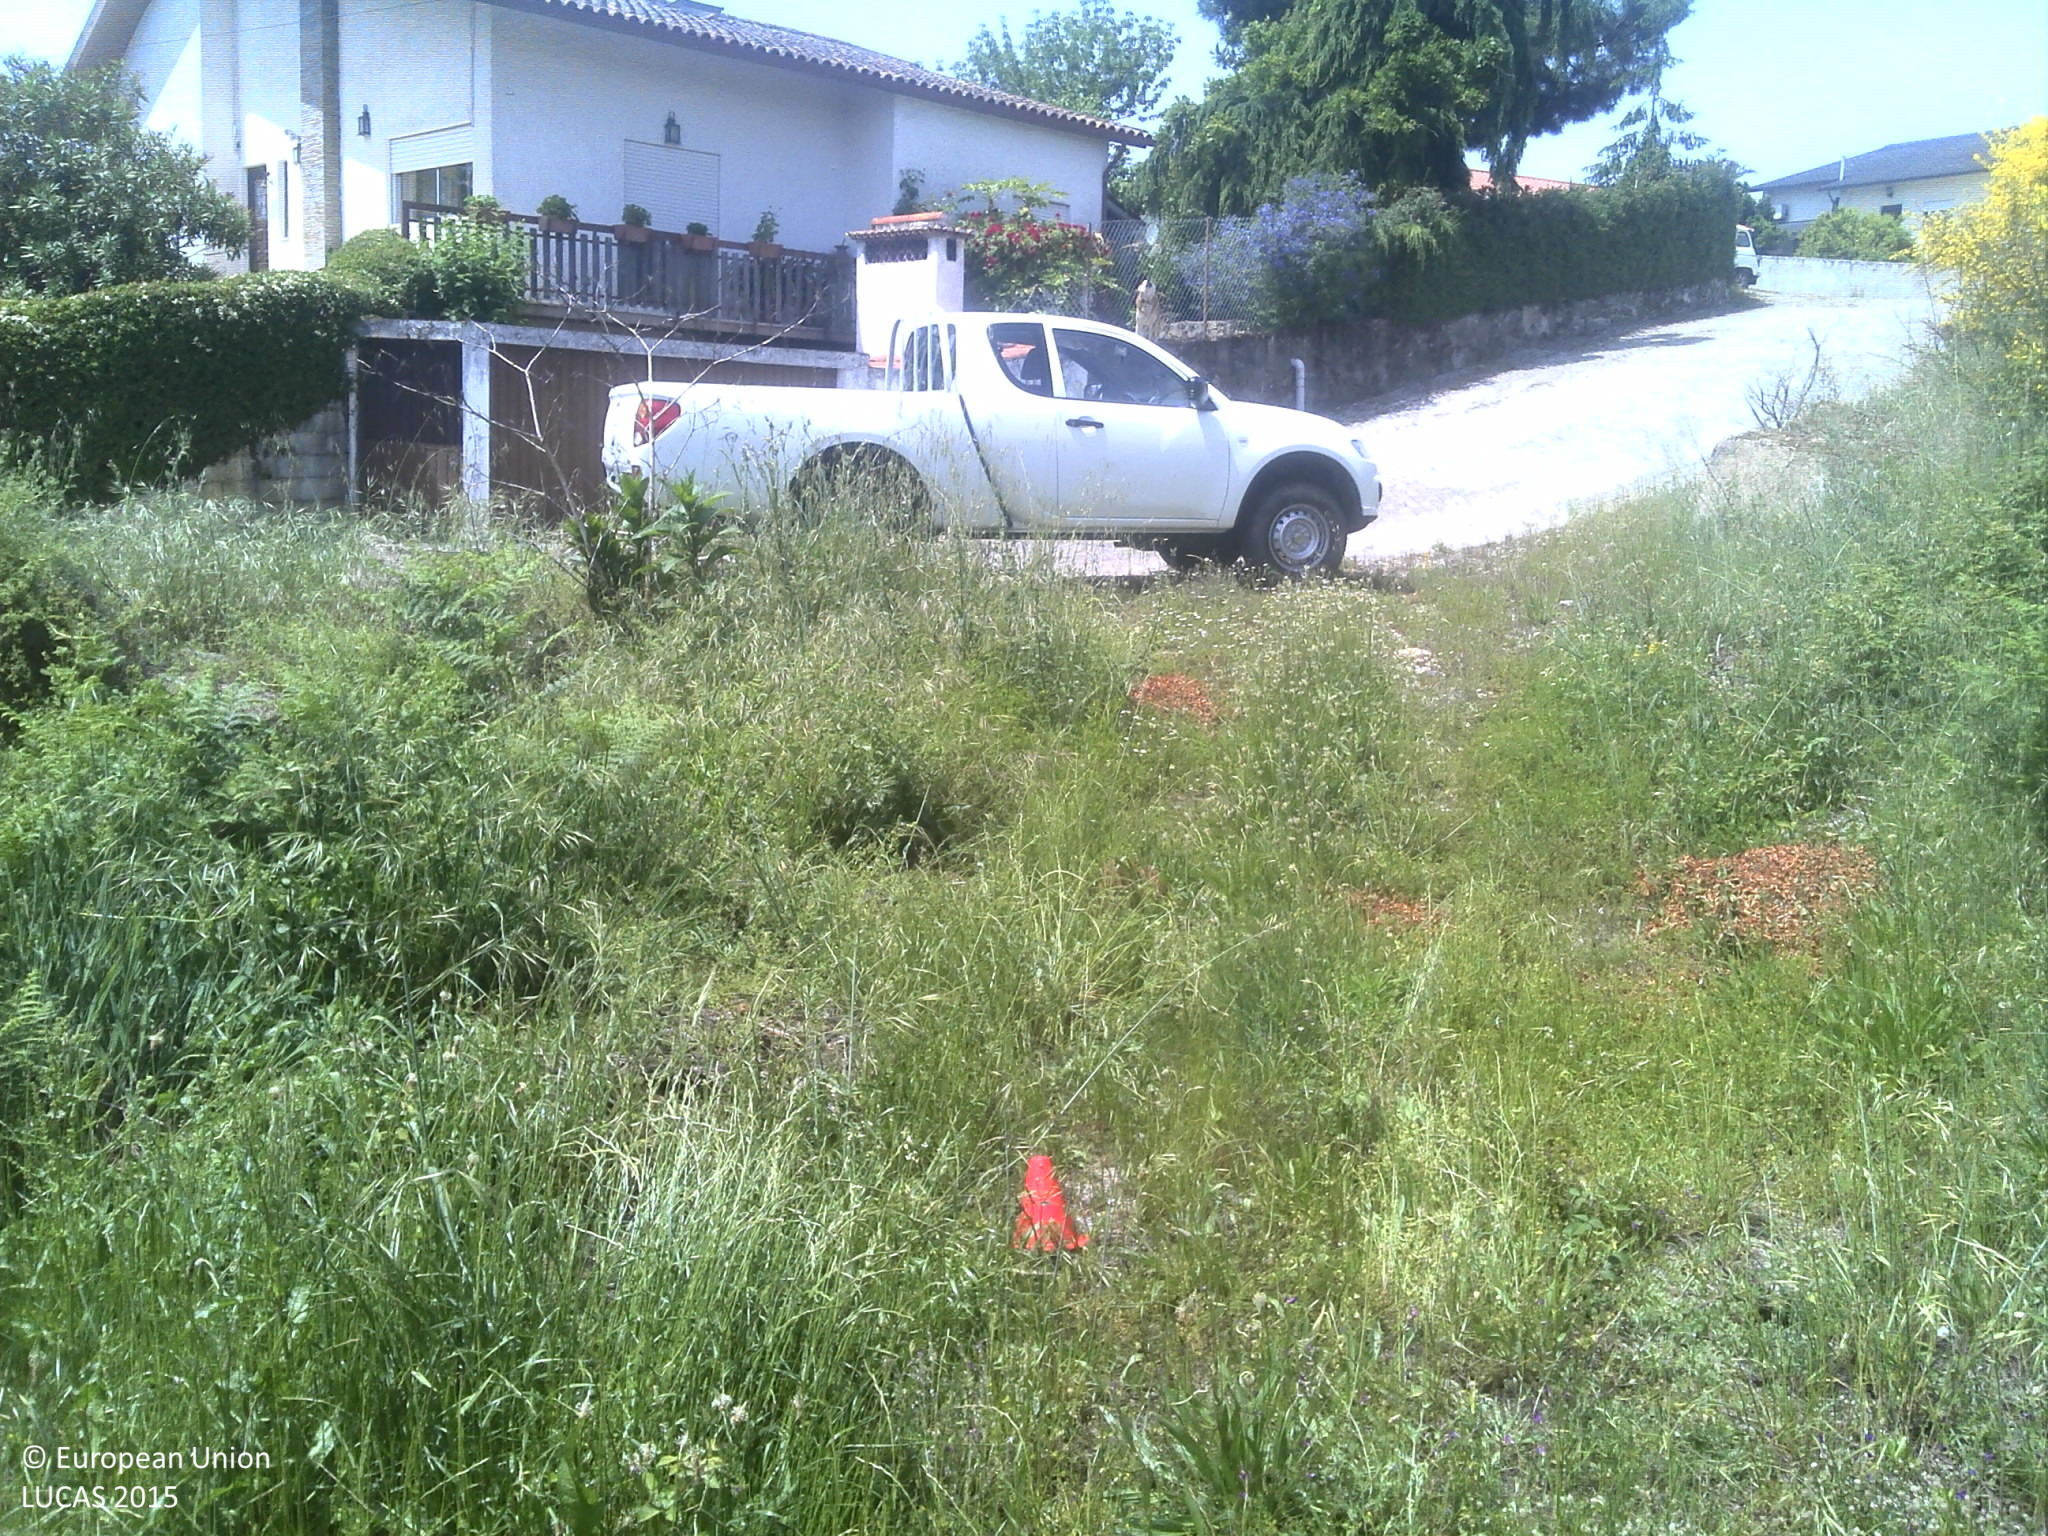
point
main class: Shrubland
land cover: Shrubland without tree cover
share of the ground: 25 - 50 %
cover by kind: shrubs 65 %, herbaceous plants 20 %, consolidated bare surface 15 %
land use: Abandoned areas
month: May
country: PT
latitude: 40.5898
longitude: -7.7598
